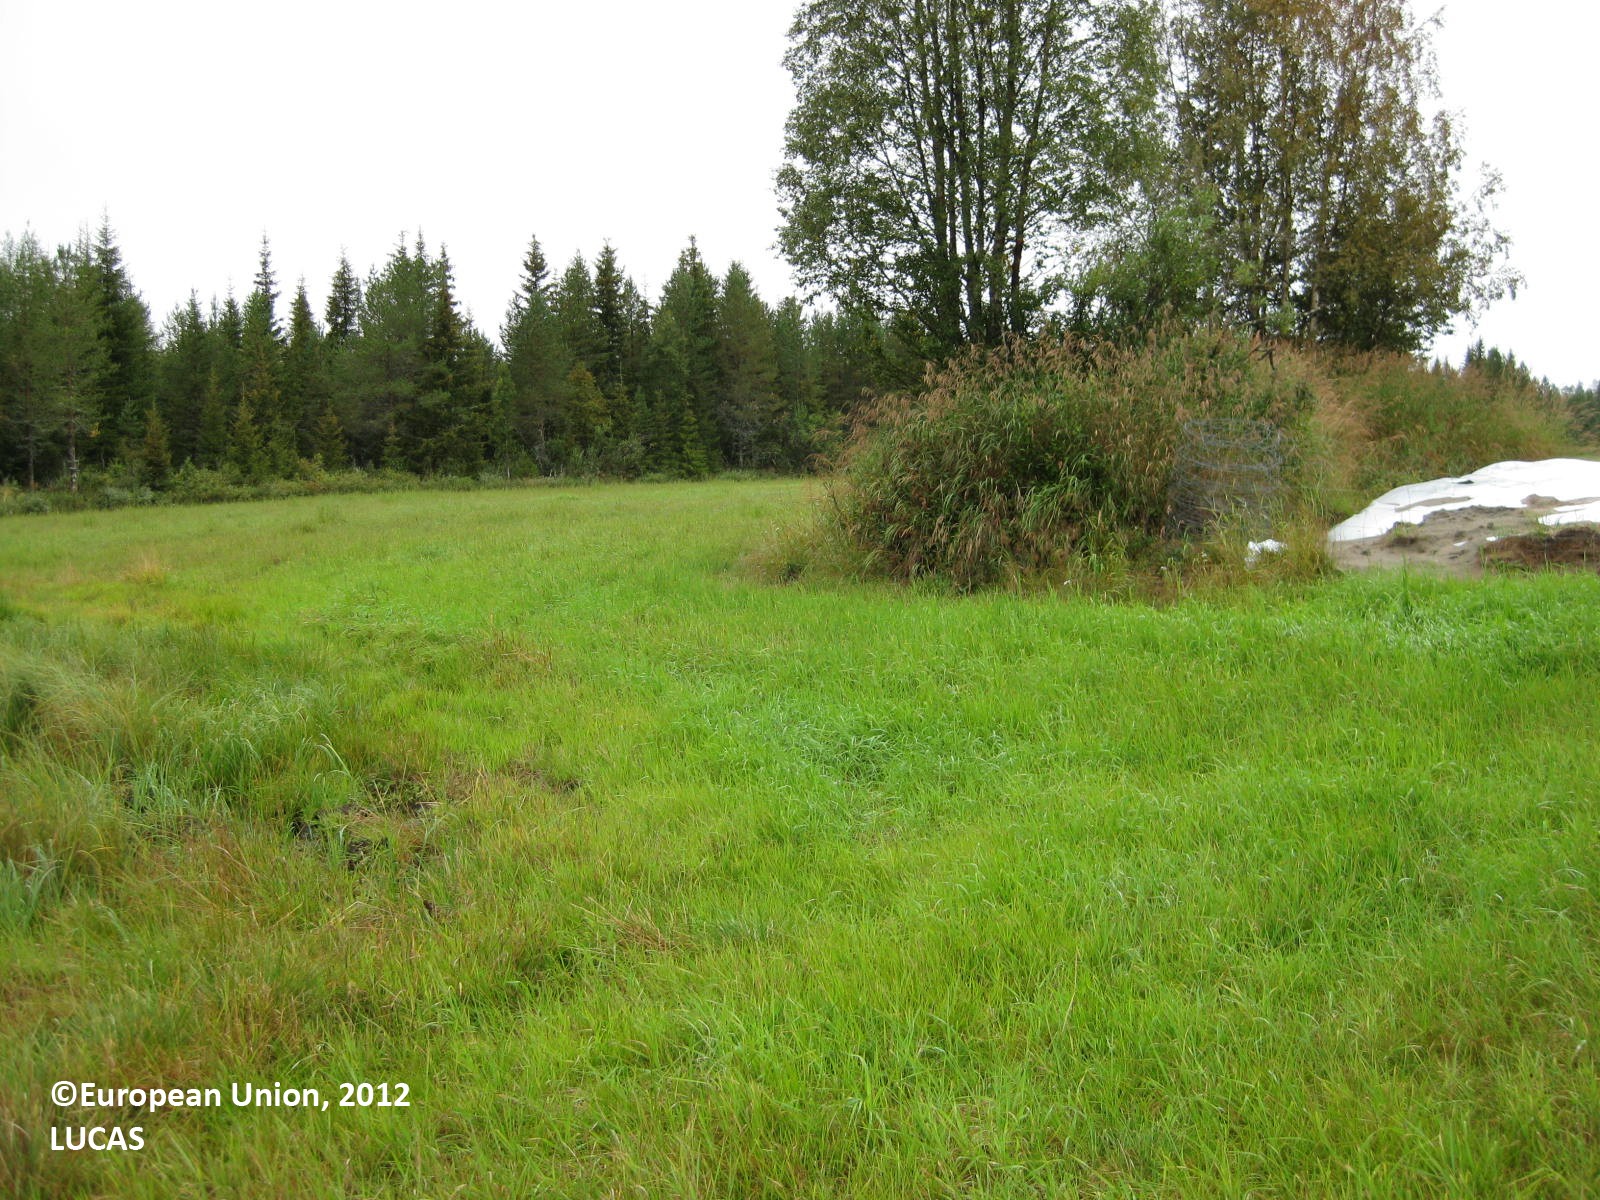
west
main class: Grassland
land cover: Grassland without tree/shrub cover
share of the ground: > 75 %
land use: Agriculture (excluding fallow land and kitchen gardens)
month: August
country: FI
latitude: 66.0293
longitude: 28.6206
